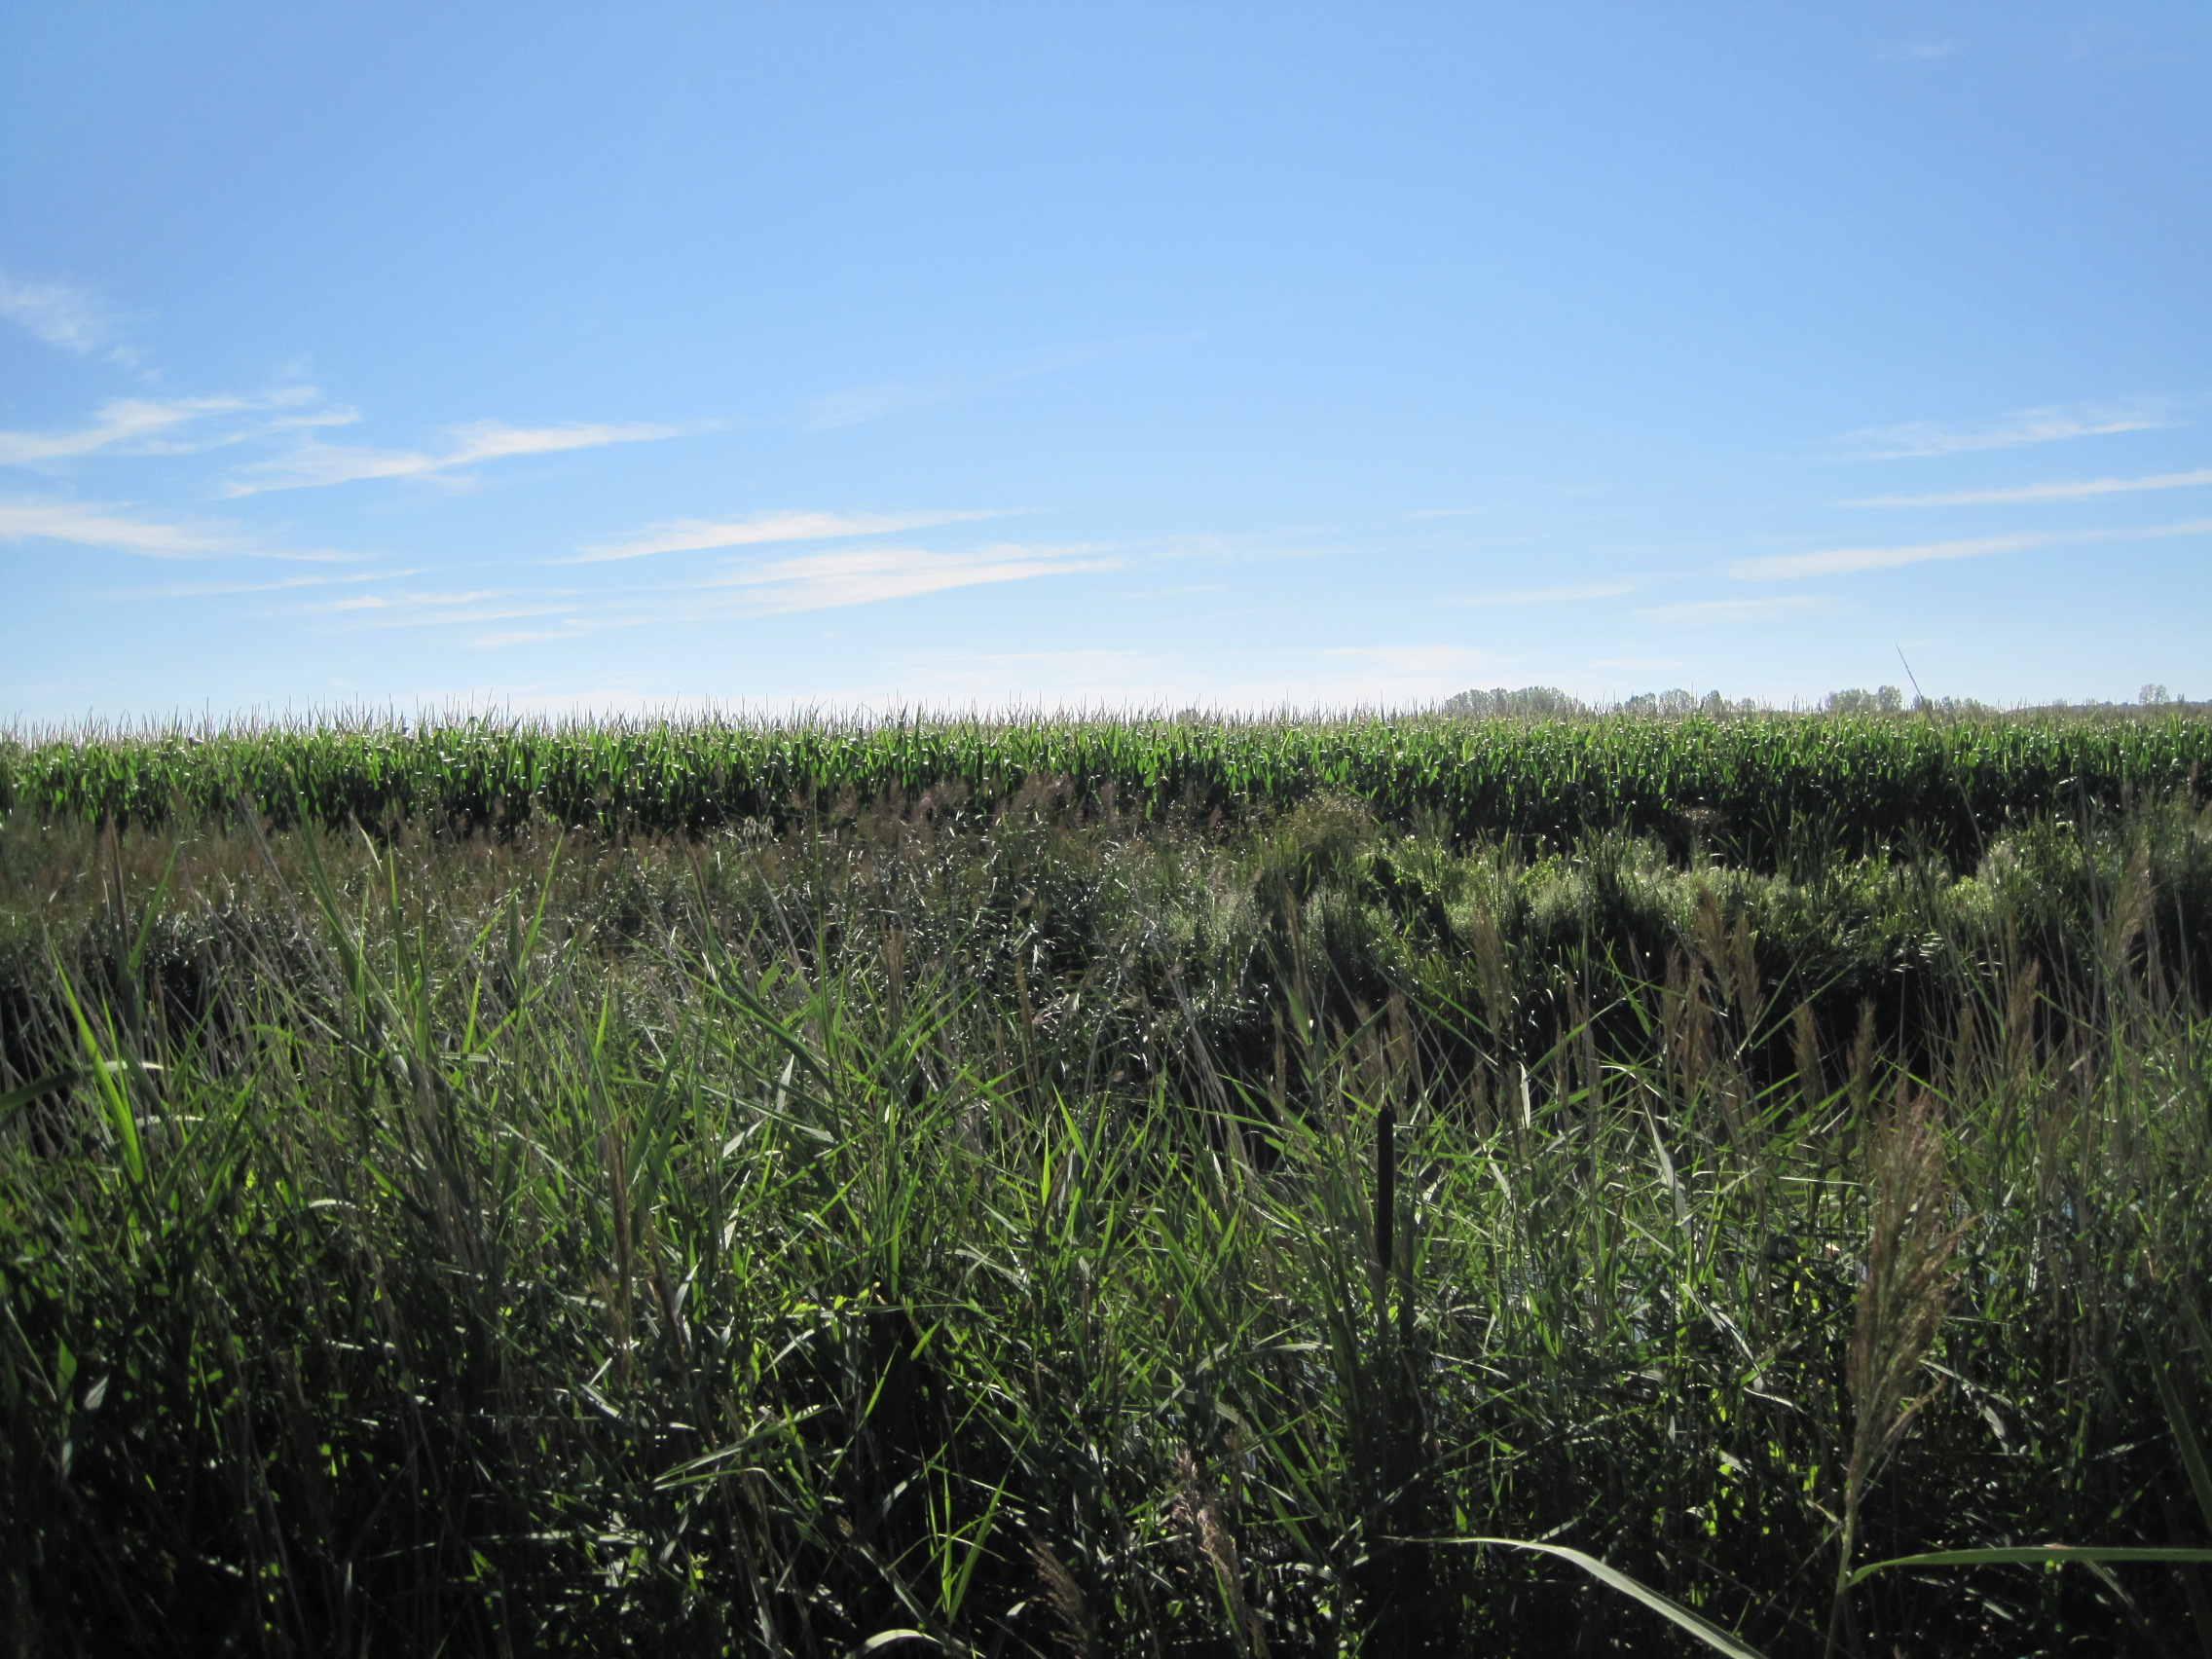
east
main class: Grassland
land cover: Grassland without tree/shrub cover
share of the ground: > 75 %
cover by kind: herbaceous plants 100 %
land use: Semi-natural and natural areas not in use
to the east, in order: Grassland without tree/shrub cover; Maize; Fences; Grass margins; Barley
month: July
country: ES
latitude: 42.0793
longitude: -5.5998
